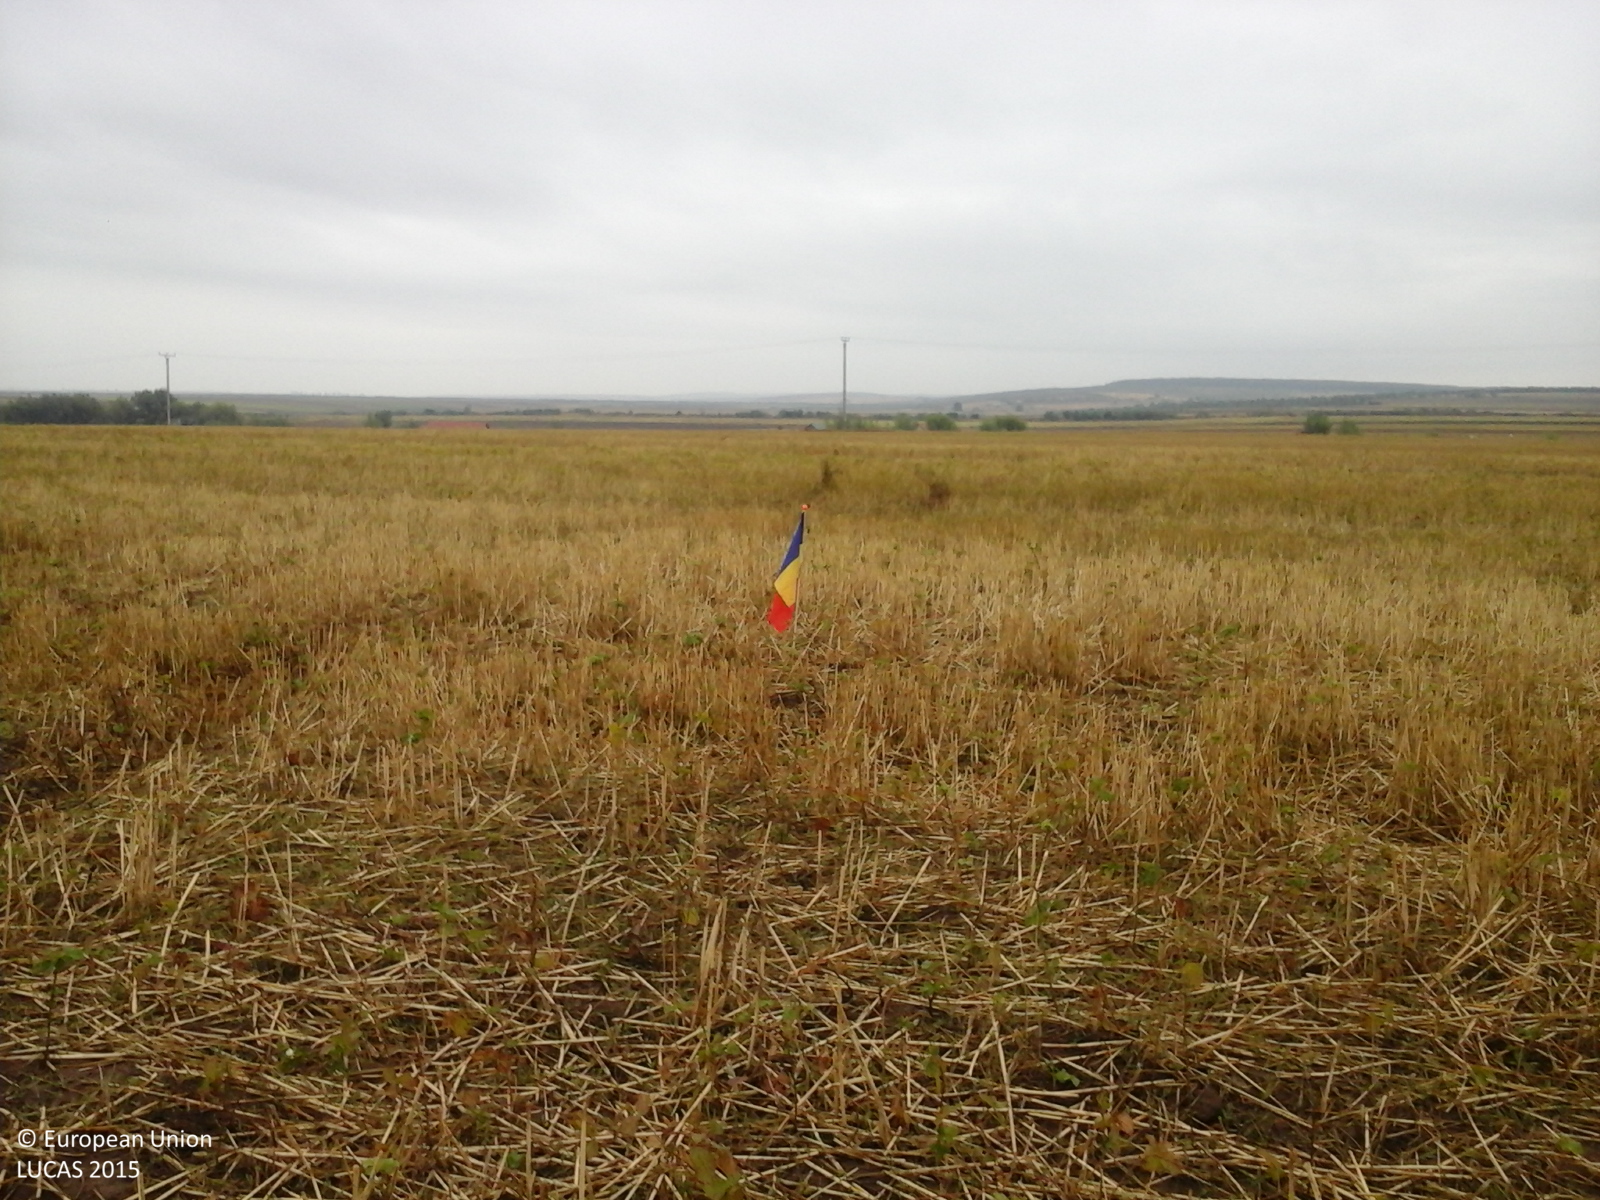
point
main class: Cropland
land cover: Common wheat
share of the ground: > 75 %
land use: Agriculture (excluding fallow land and kitchen gardens)
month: August
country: RO
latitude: 46.0232
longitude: 21.4671
